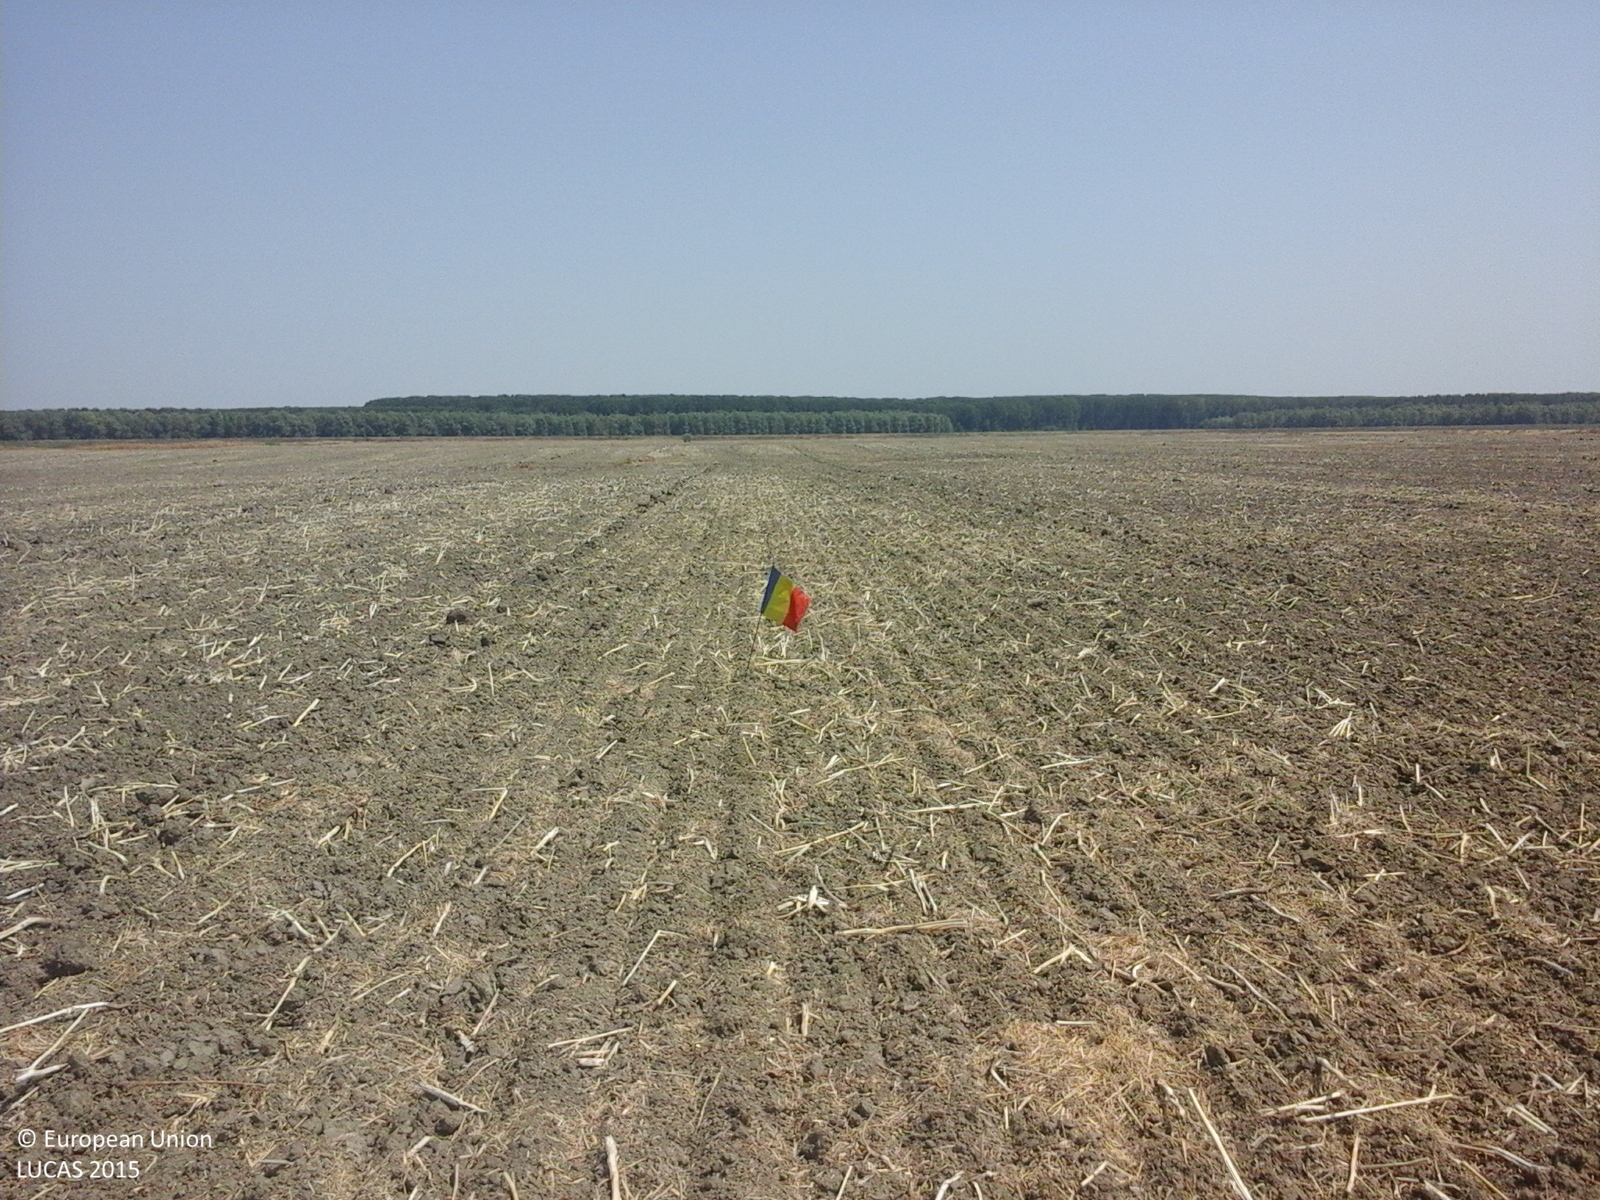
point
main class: Cropland
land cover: Rape and turnip rape
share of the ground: 10 - 25 %
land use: Agriculture (excluding fallow land and kitchen gardens)
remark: Harvested field
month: August
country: RO
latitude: 45.0428
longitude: 28.1320
